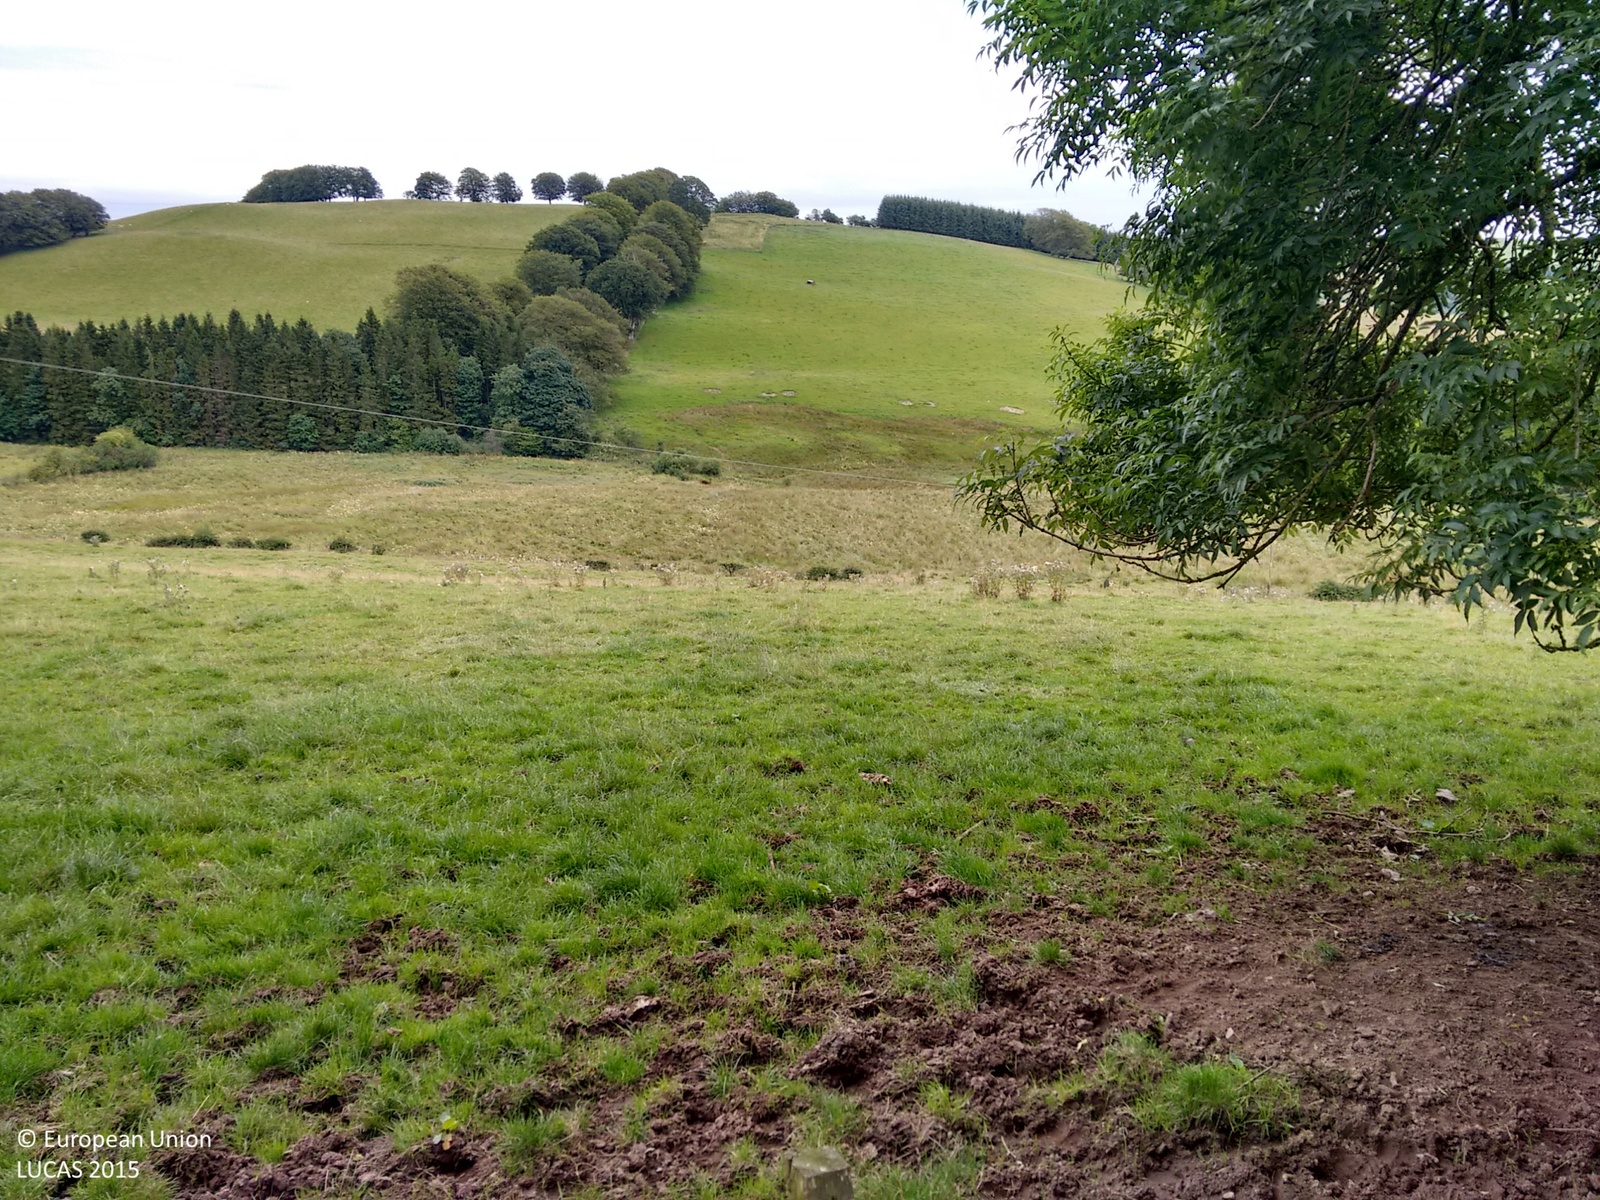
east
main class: Grassland
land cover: Grassland without tree/shrub cover
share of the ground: > 75 %
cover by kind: herbaceous plants 100 %
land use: Agriculture (excluding fallow land and kitchen gardens)
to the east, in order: Grassland without tree/shrub cover; Fences; Single bushes/trees; Grassland without tree/shrub cover; Peatbogs; Rivers and streams; Broadleaved woodland; Grassland without tree/shrub cover; Fences; Abandoned hedges
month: August
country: GB
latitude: 55.1939
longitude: -3.3512
